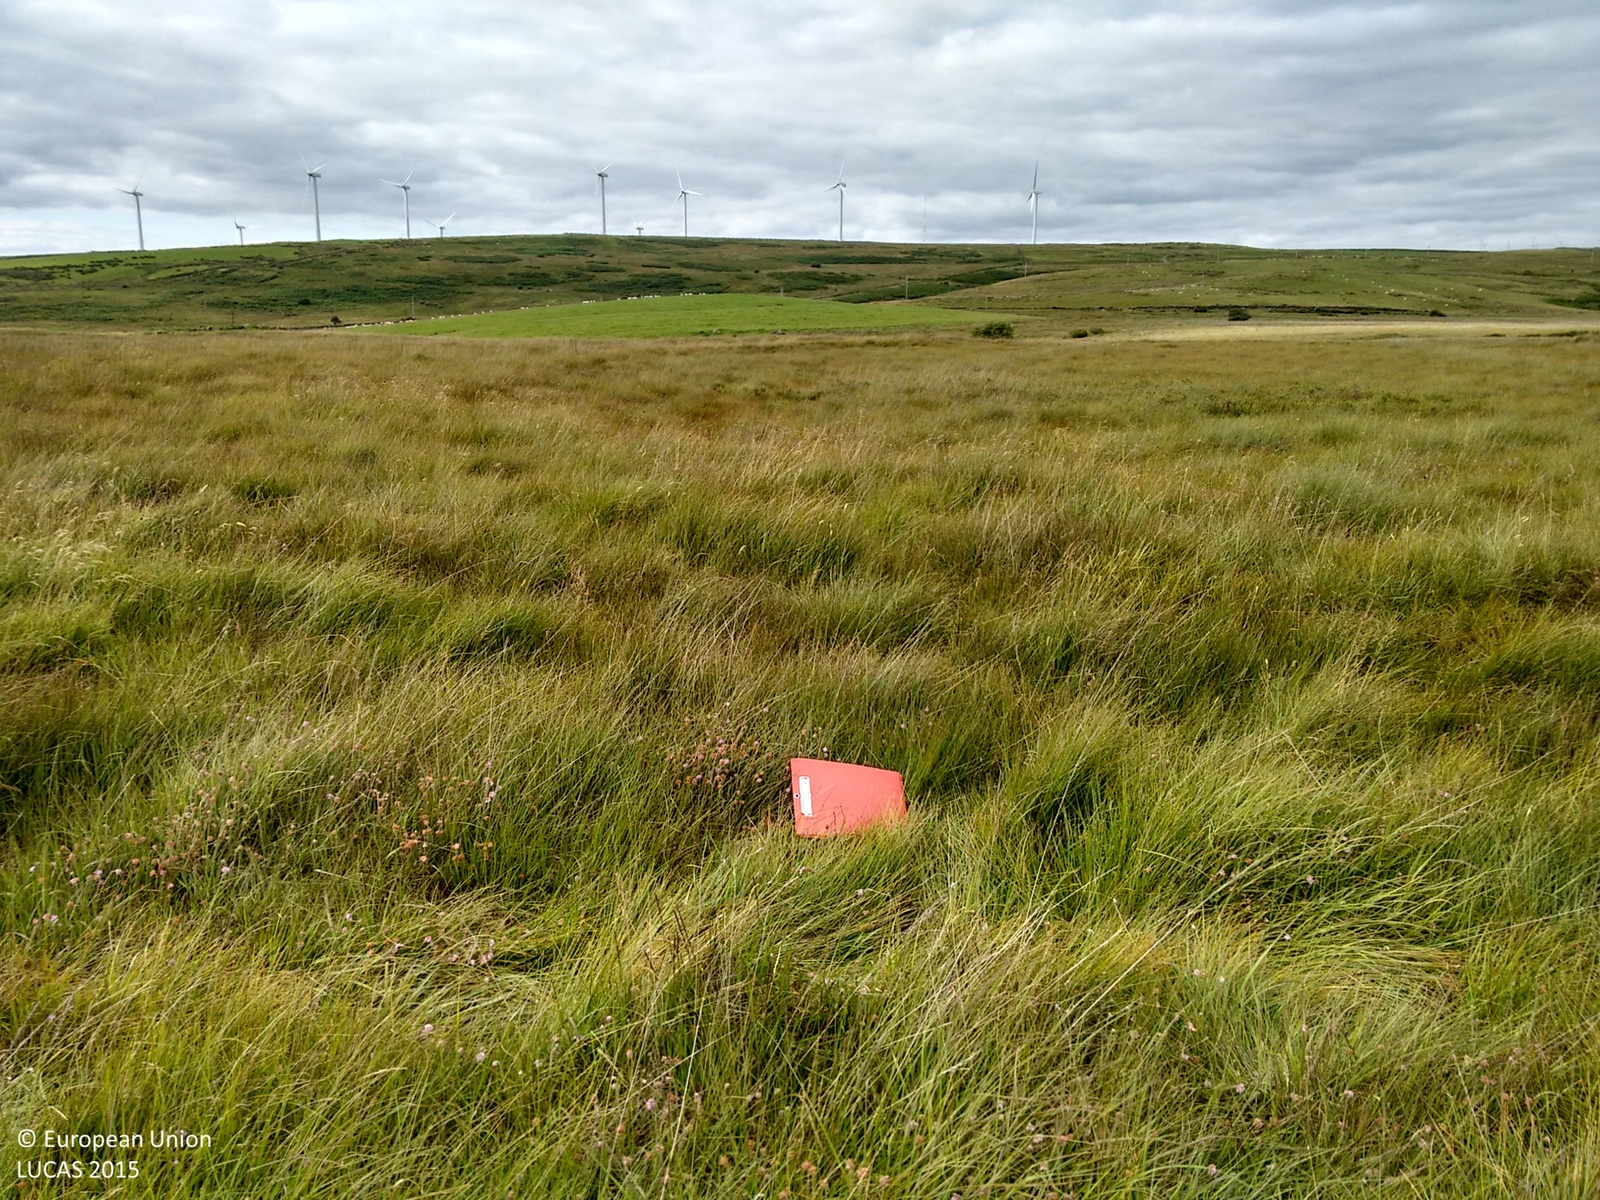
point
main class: Grassland
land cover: Grassland without tree/shrub cover
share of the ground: > 75 %
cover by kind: herbaceous plants 100 %
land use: Agriculture (excluding fallow land and kitchen gardens)
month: August
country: GB
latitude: 54.9070
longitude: -4.7533
